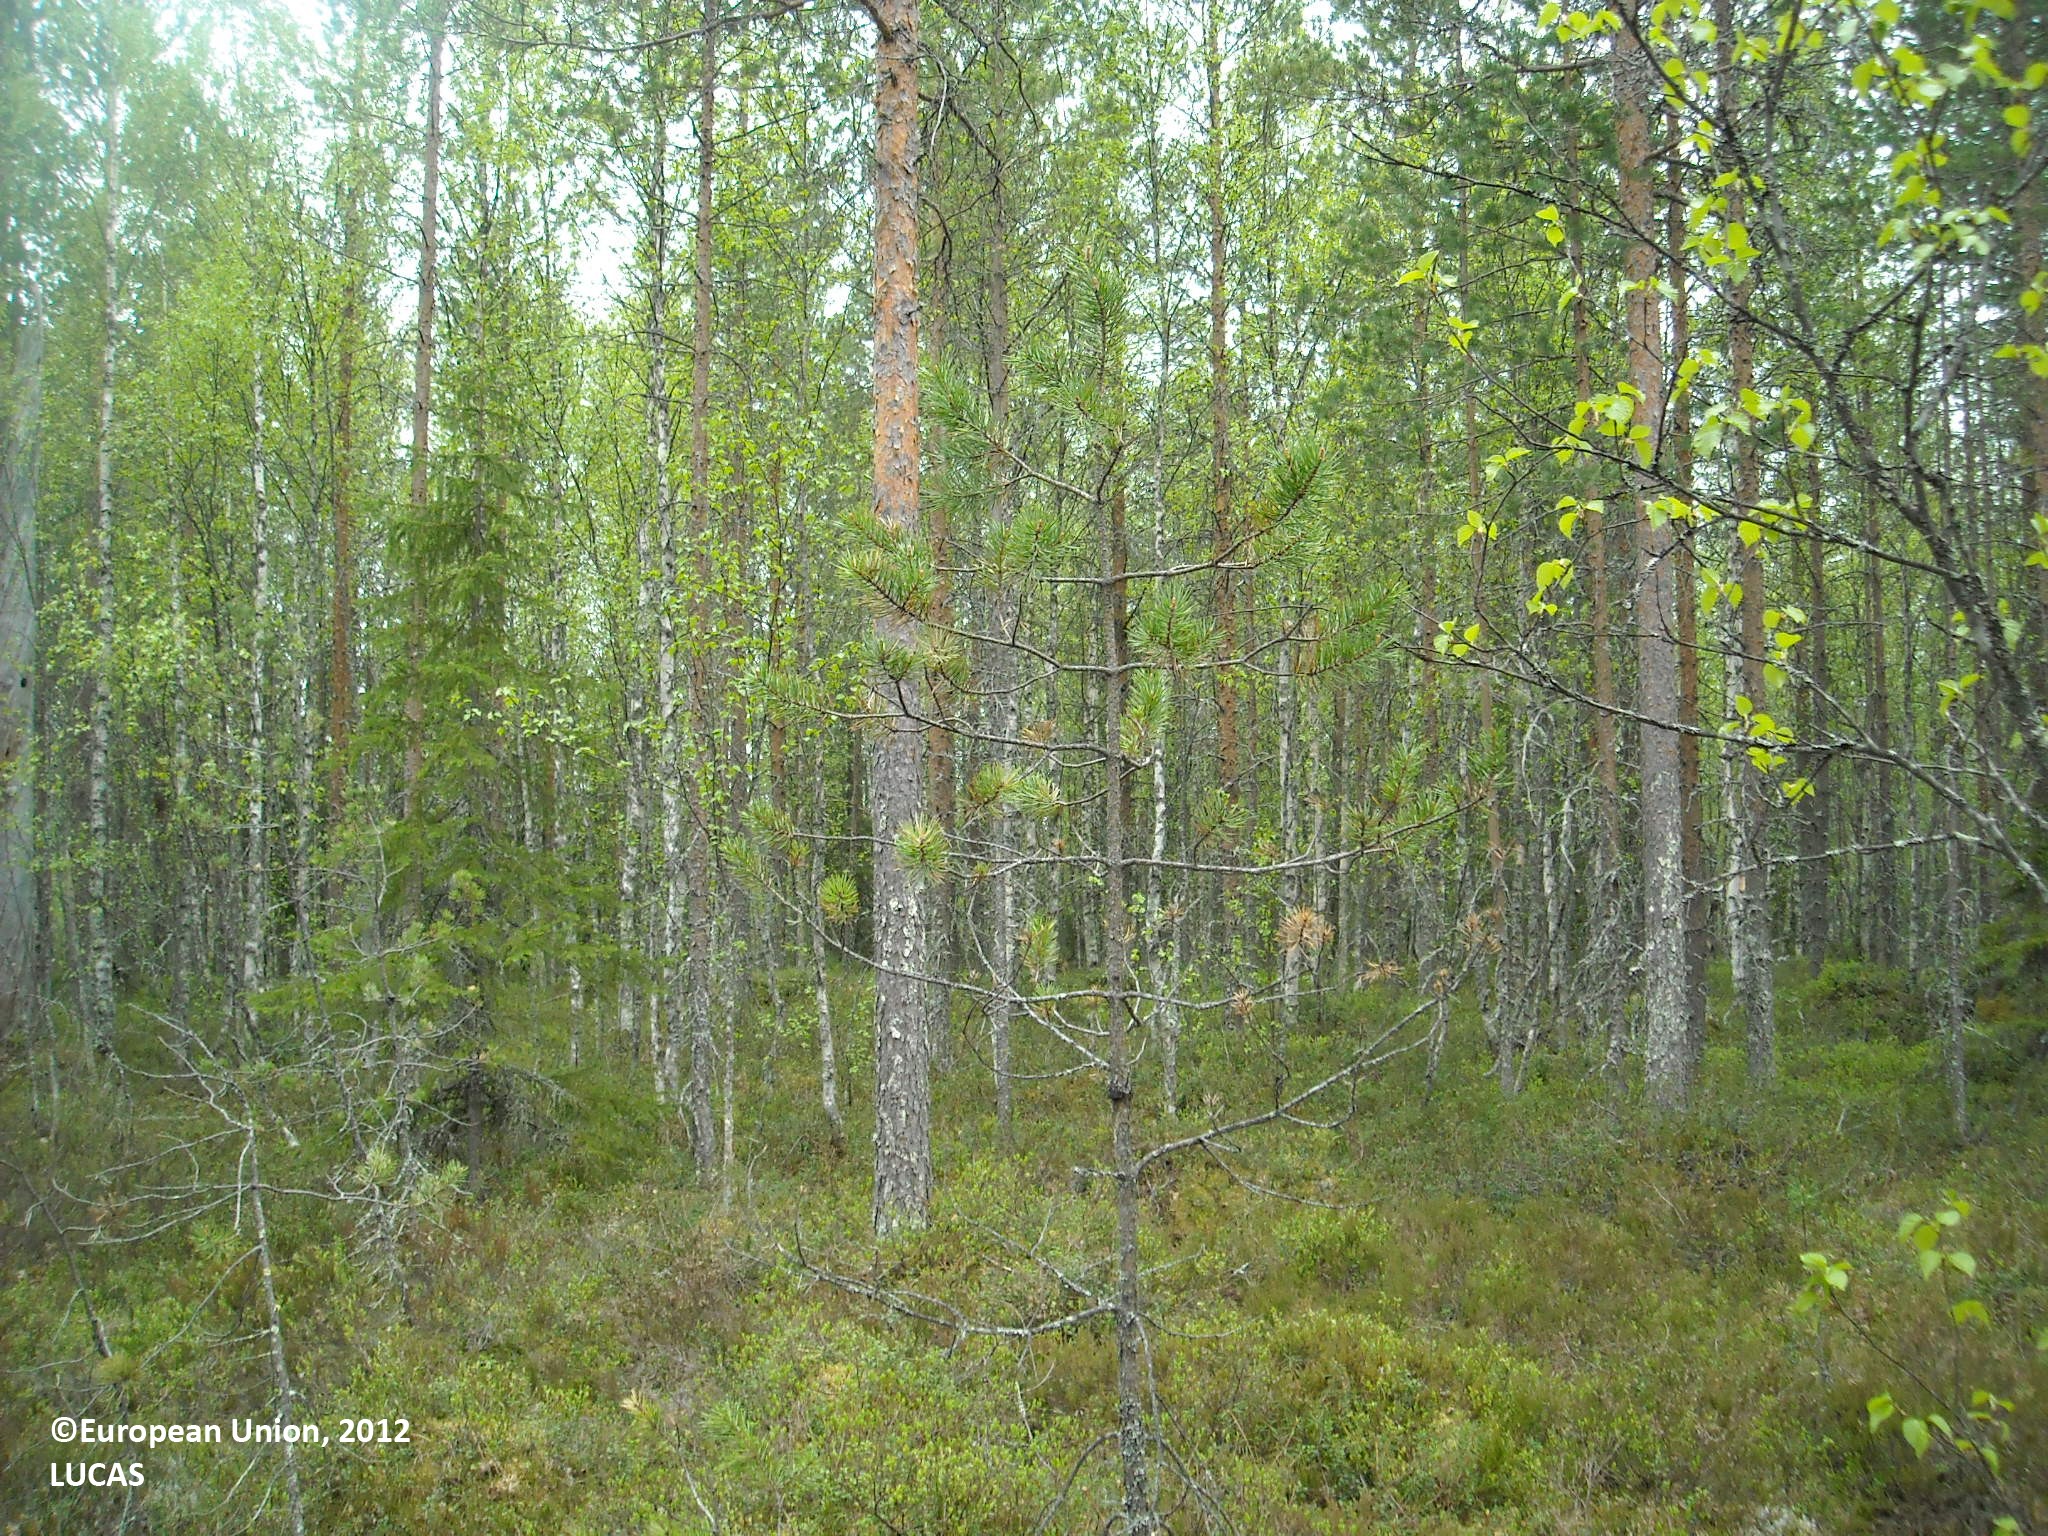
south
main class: Woodland
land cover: Pine dominated coniferous woodland
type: mire and swamp forests
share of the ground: > 75 %
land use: Forestry
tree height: > 5 m
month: June
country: FI
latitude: 64.6432
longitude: 27.3177
